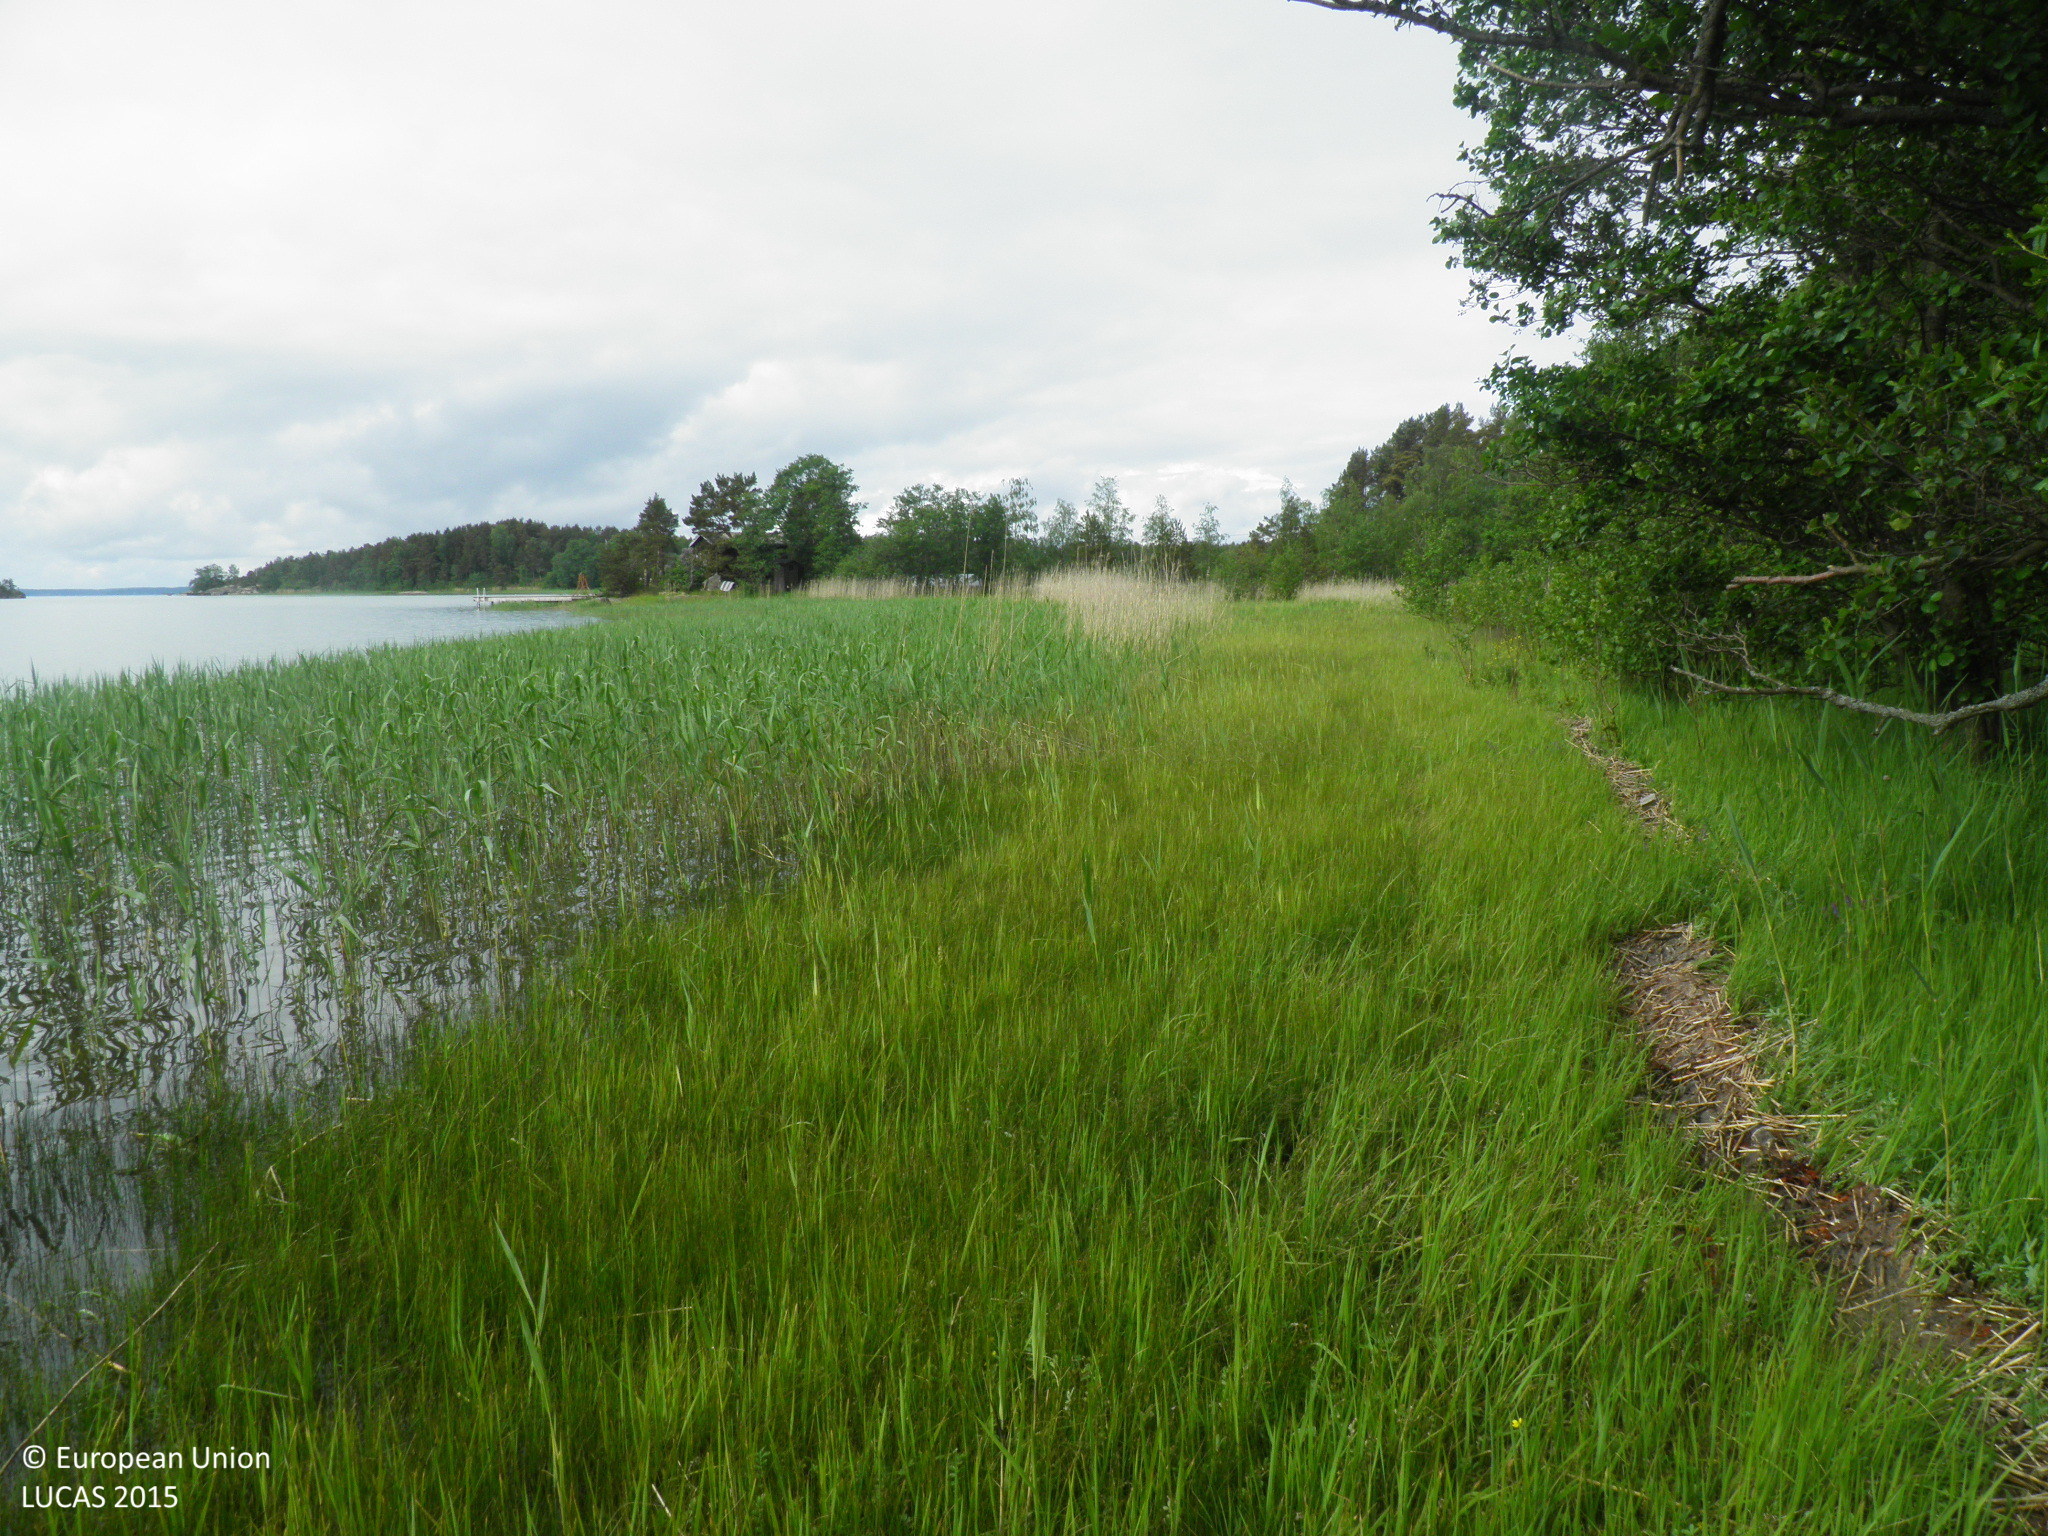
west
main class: Woodland
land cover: Pine dominated coniferous woodland
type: boreal forest
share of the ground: 50 - 75 %
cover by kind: coniferous forest trees 50 %, lichens and mosses 40 %, consolidated bare surface 10 %
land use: Forestry
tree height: > 5 m
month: June
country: FI
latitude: 60.4918
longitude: 21.5052
